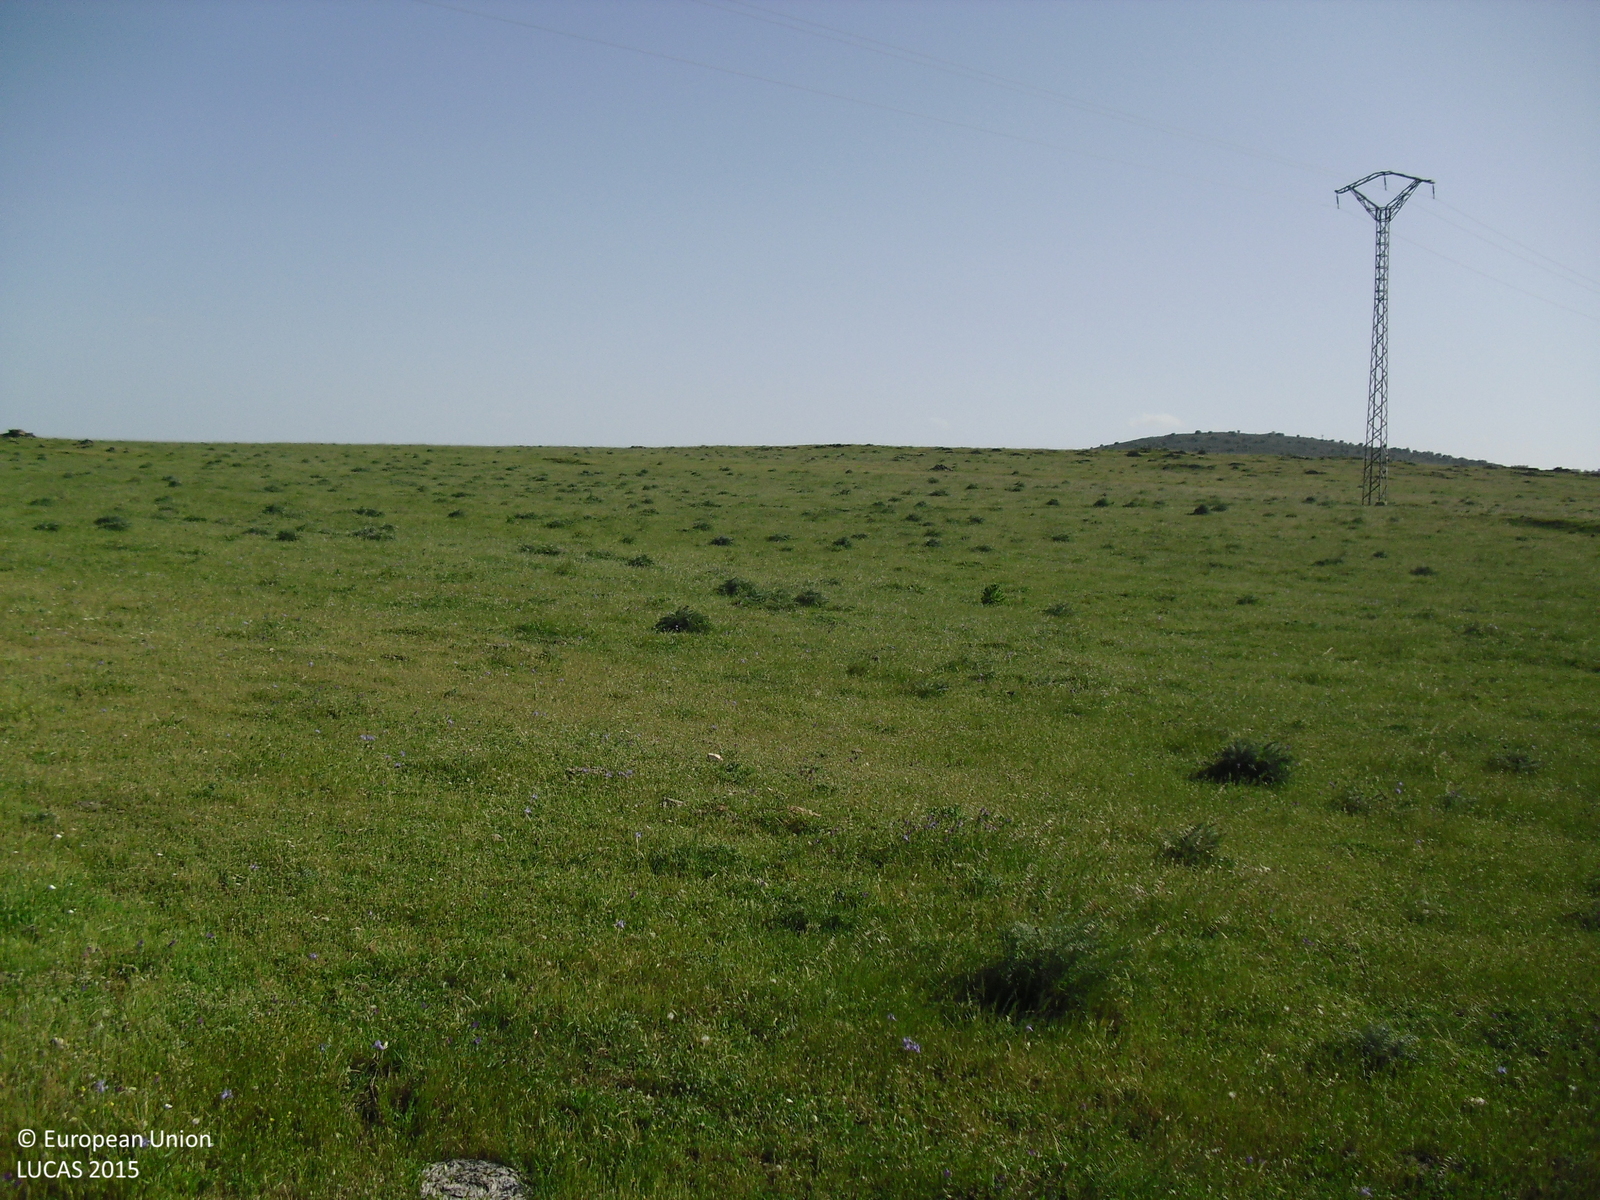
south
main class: Grassland
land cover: Grassland without tree/shrub cover
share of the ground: > 75 %
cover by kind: herbaceous plants 100 %
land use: Agriculture (excluding fallow land and kitchen gardens)
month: April
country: ES
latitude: 39.5054
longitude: -6.3854
